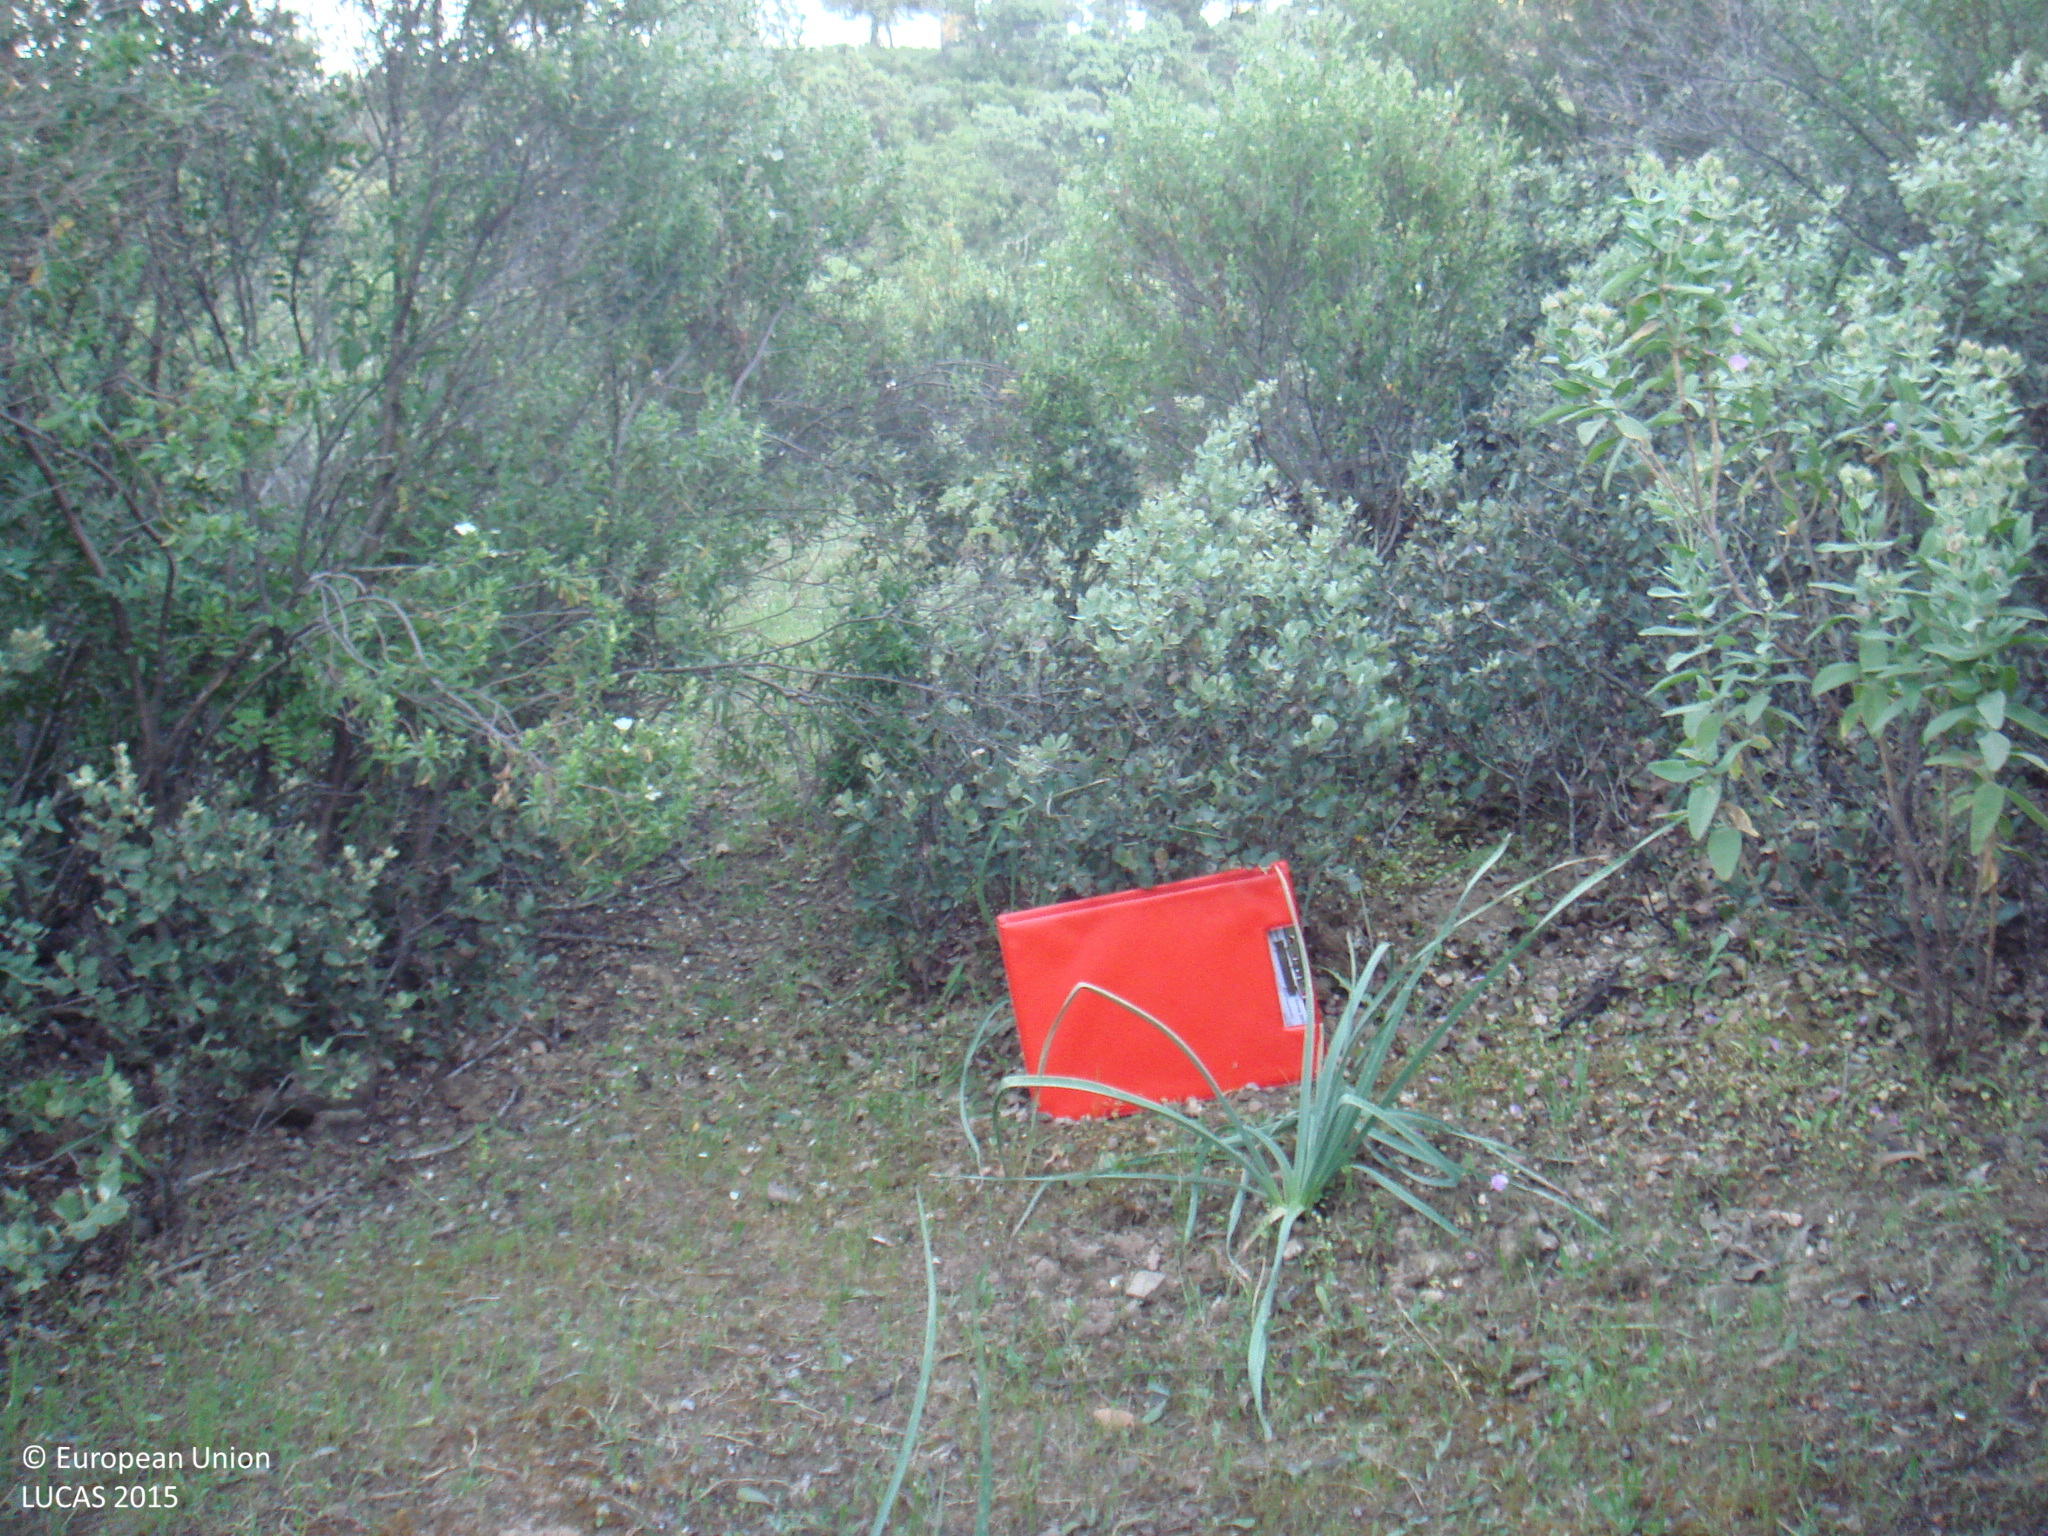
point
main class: Shrubland
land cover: Shrubland with sparse tree cover
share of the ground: 50 - 75 %
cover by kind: herbaceous plants 55 %, shrubs 40 %, broadleaved forest trees 5 %
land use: Forestry
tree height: > 5 m
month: April
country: ES
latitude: 38.0681
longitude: -4.7092
